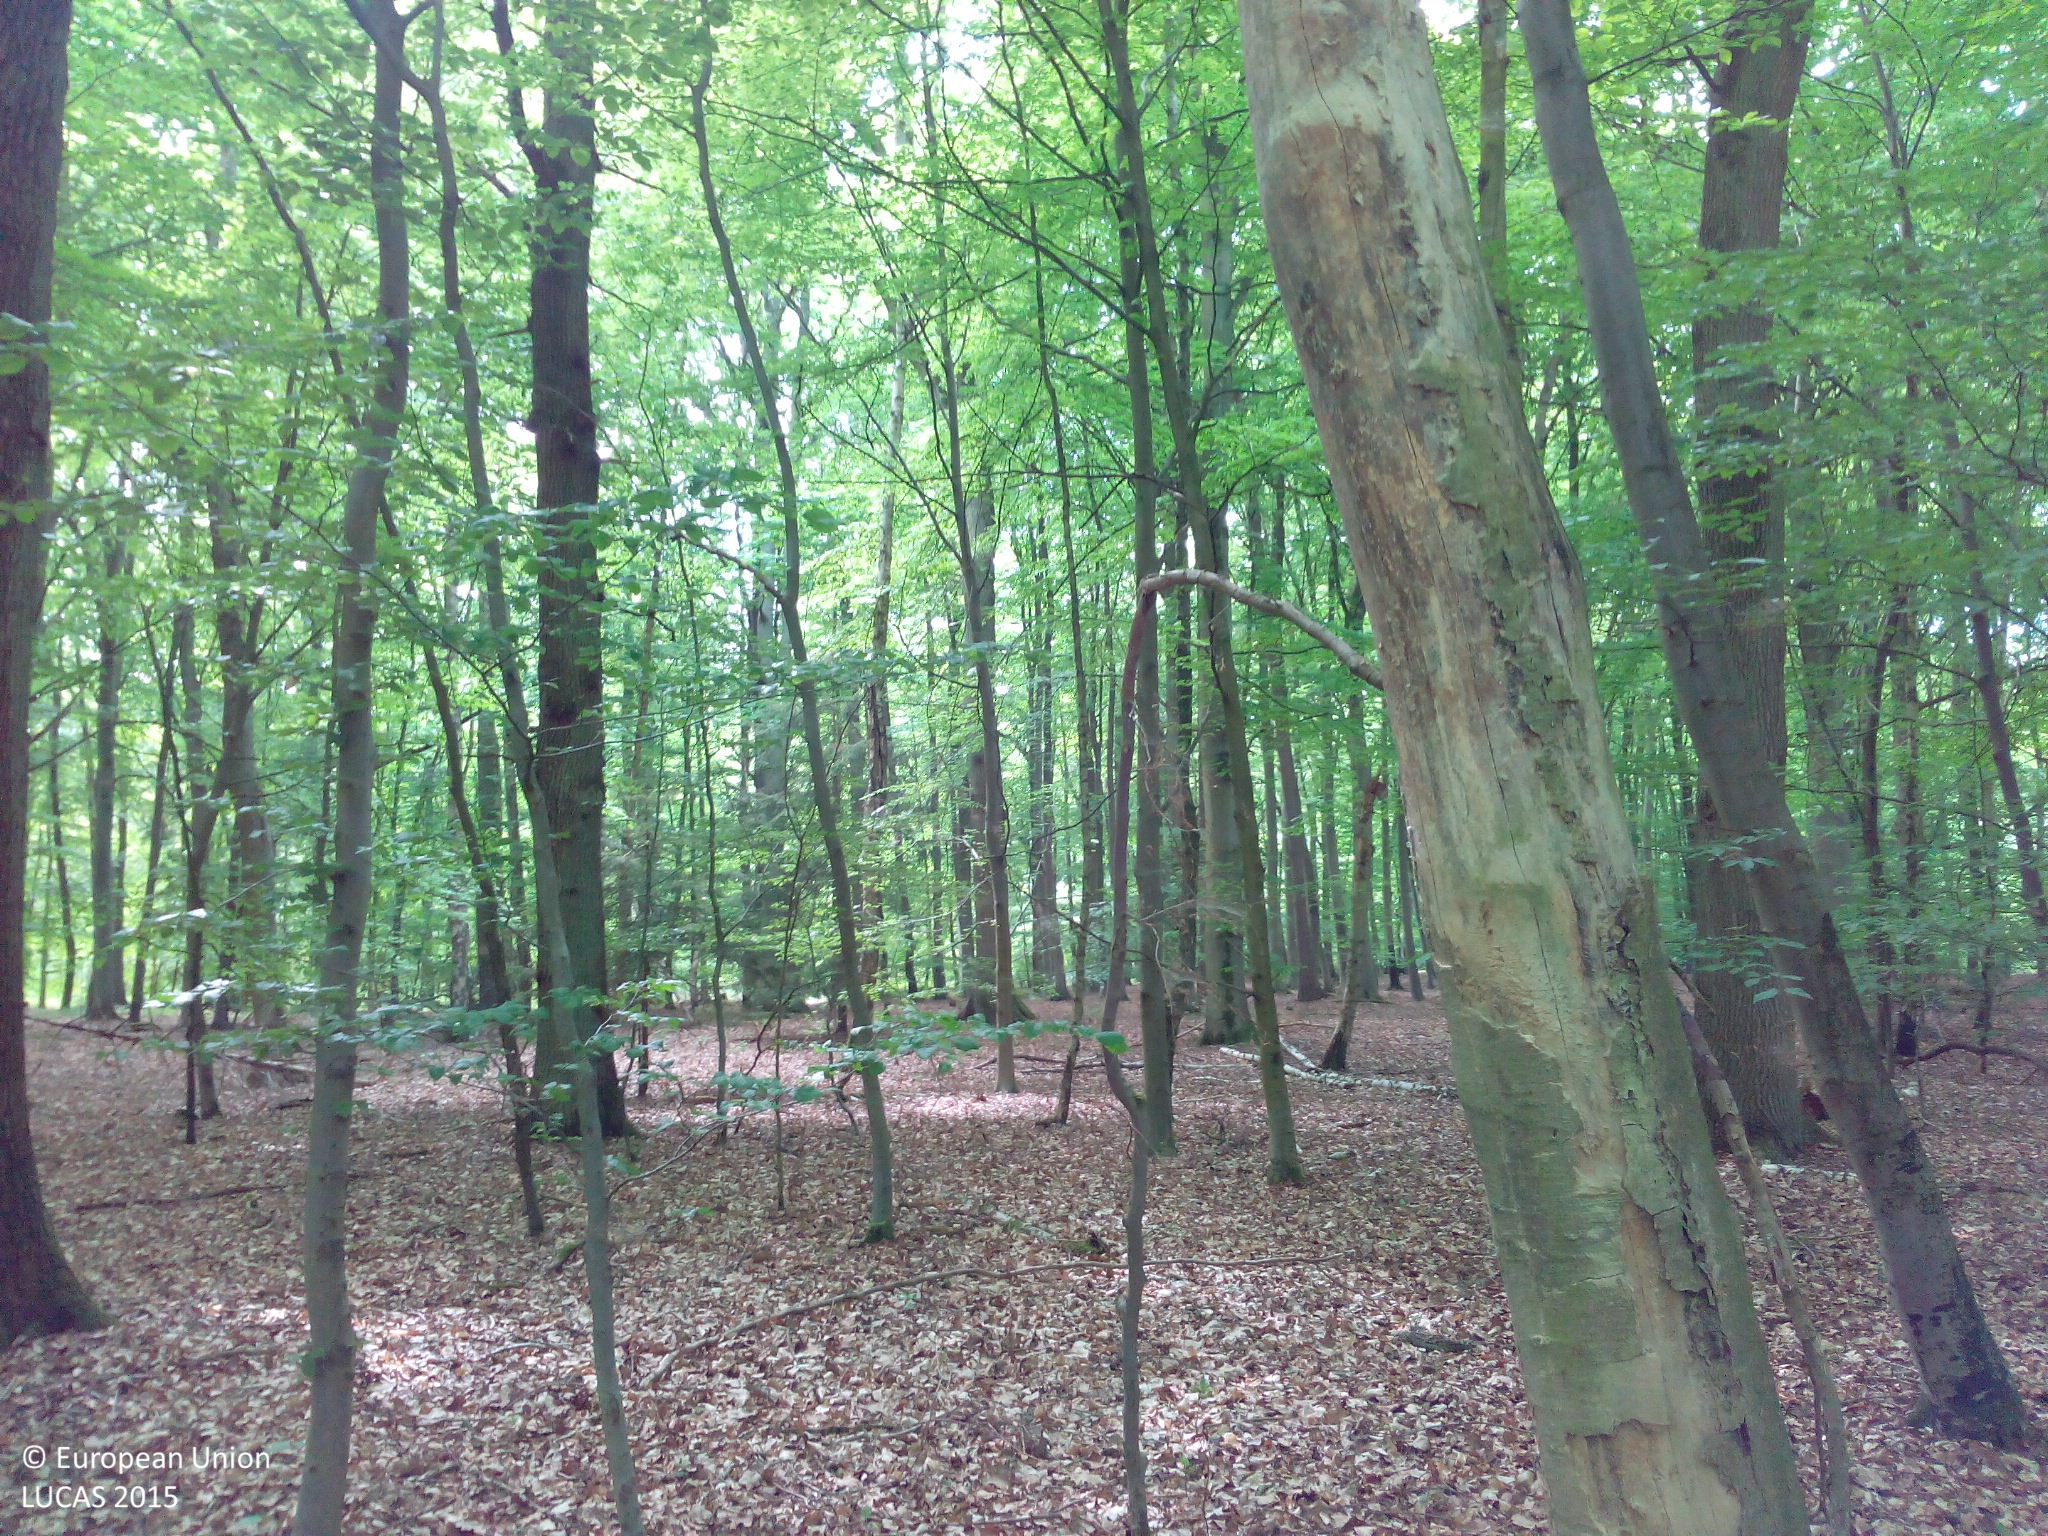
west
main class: Woodland
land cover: Broadleaved woodland
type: beech forest
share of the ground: 25 - 50 %
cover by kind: broadleaved forest trees 80 %, unconsolidated bare surface 20 %
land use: Forestry
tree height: > 5 m
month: May
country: DE
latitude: 53.4987
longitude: 11.6425
